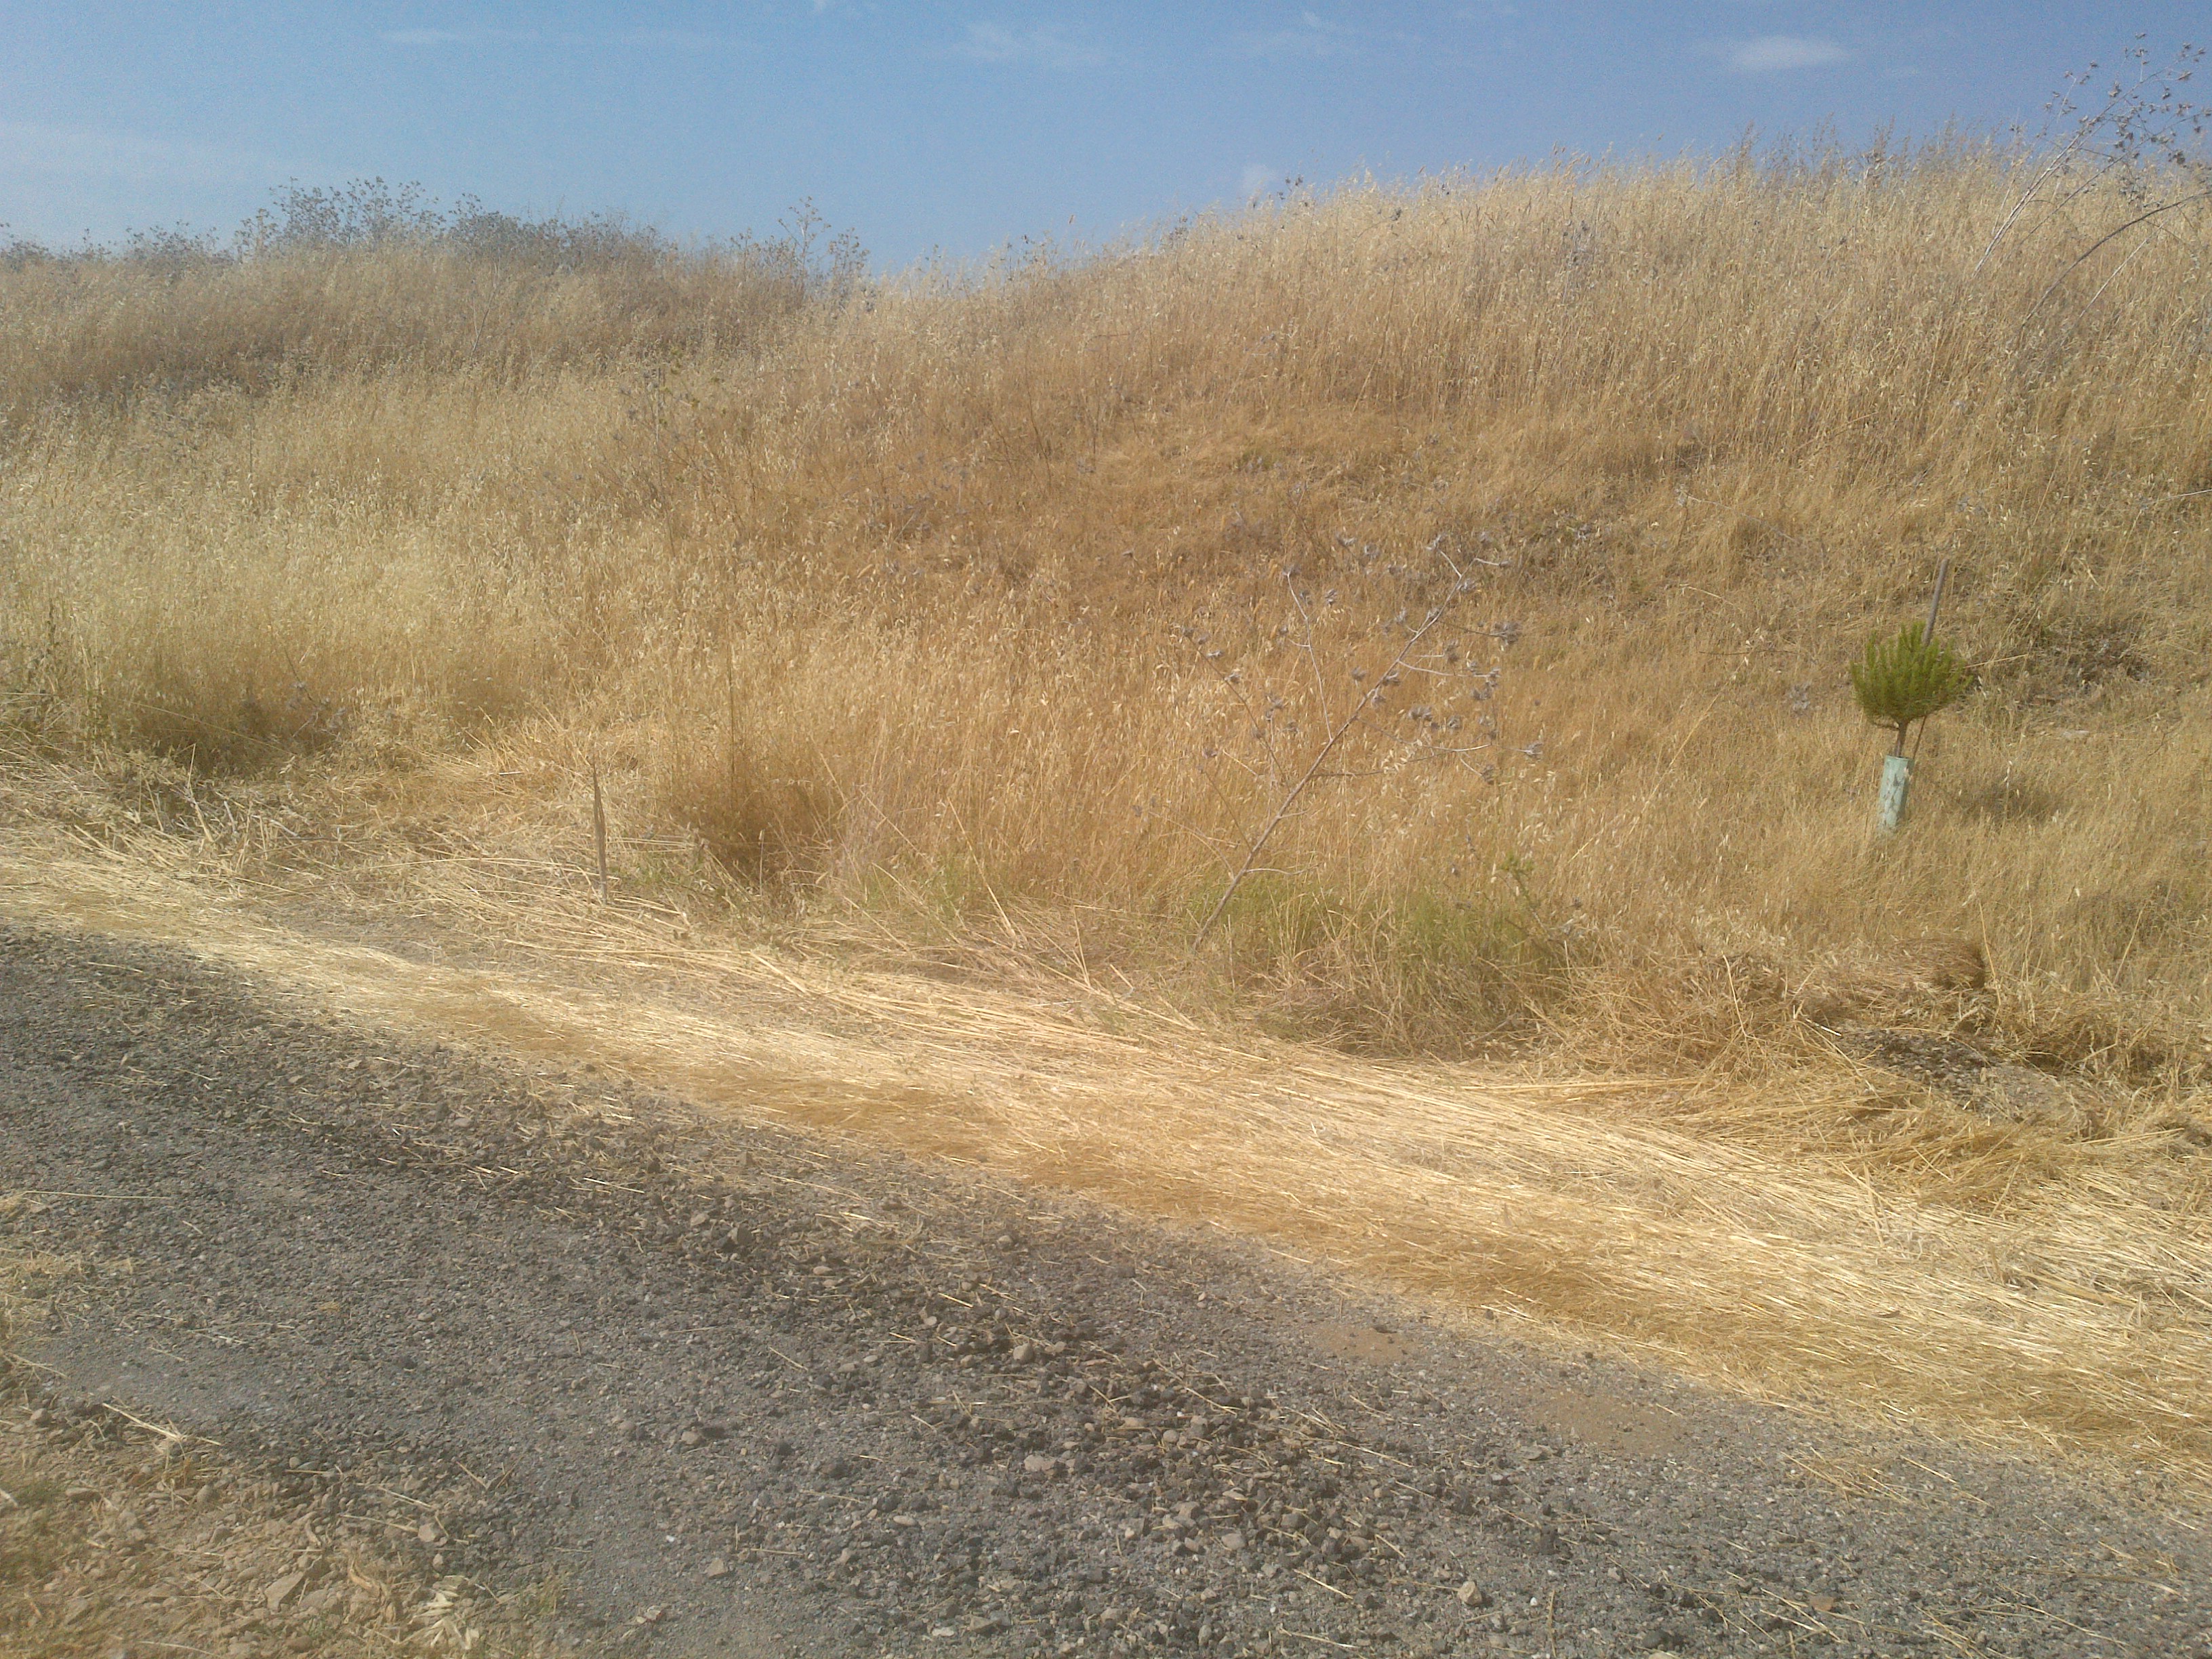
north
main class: Grassland
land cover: Grassland with sparse tree/shrub cover
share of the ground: > 75 %
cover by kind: herbaceous plants 90 %, broadleaved forest trees 5 %, unconsolidated bare surface 5 %
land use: Road transport
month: June
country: ES
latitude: 37.7596
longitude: -4.9180
